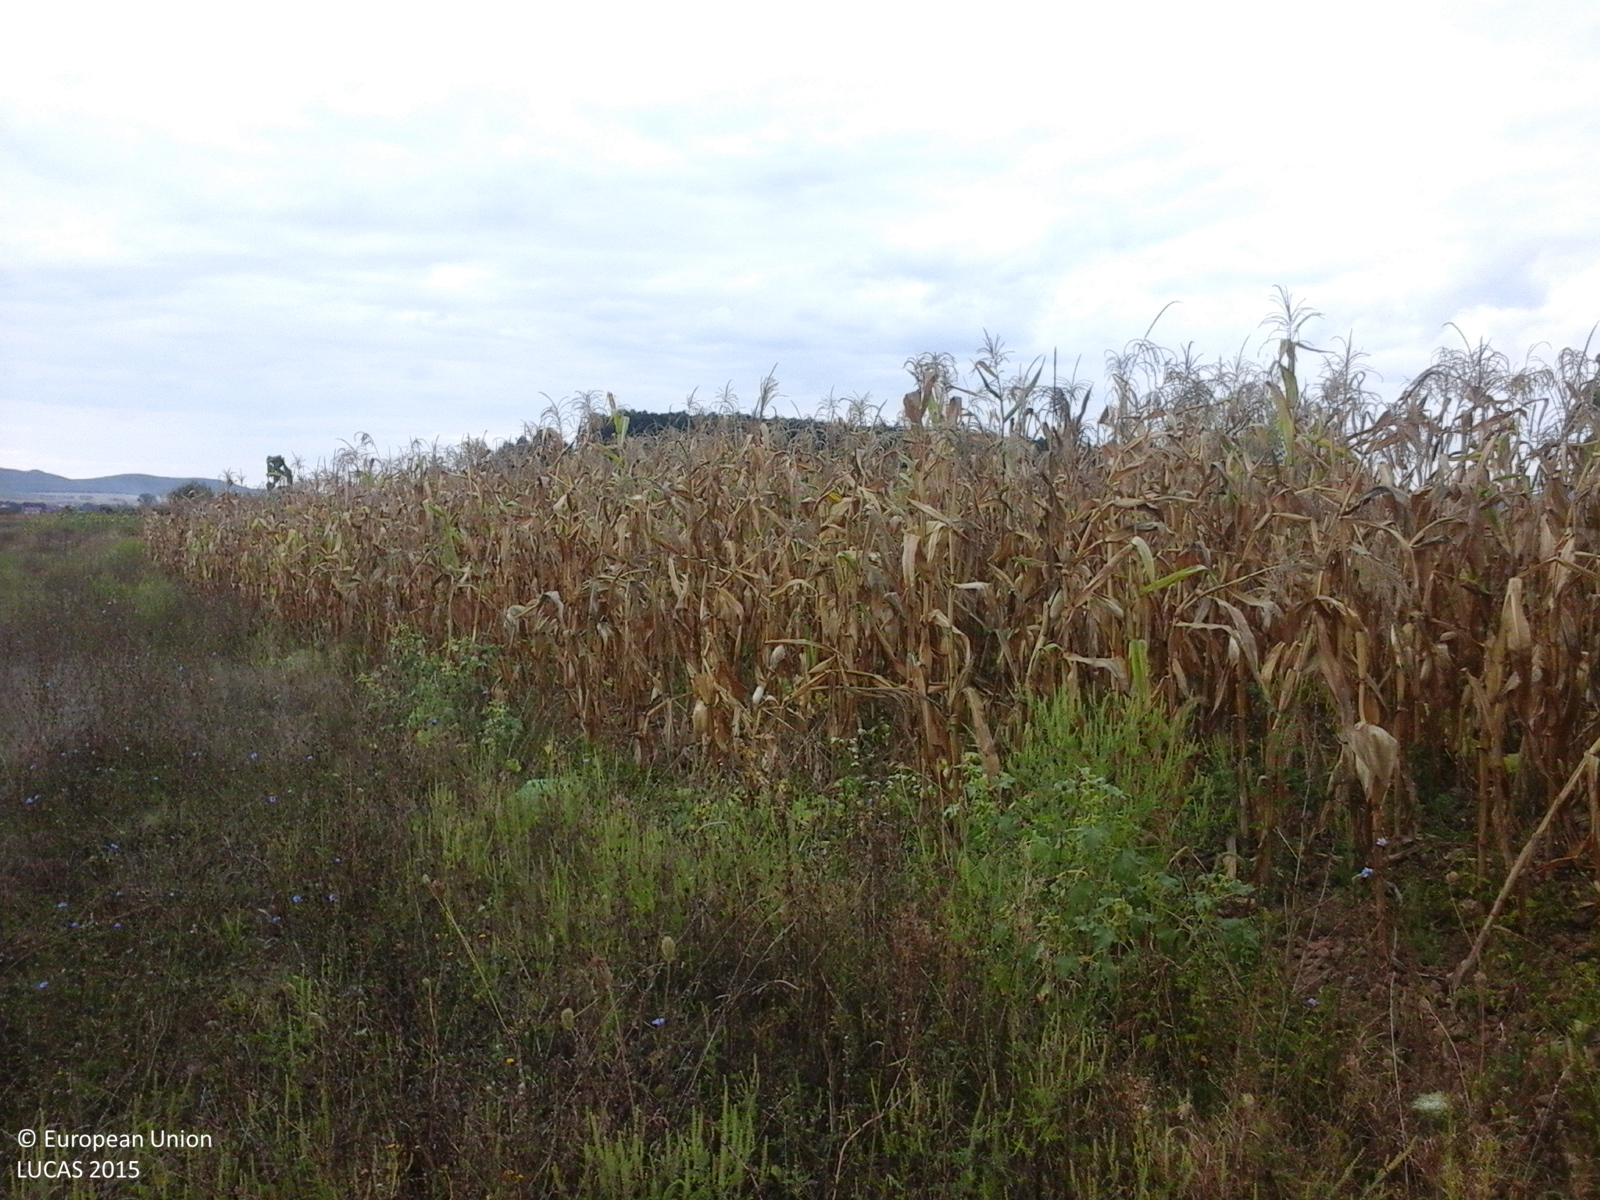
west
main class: Cropland
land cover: Maize
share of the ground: > 75 %
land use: Agriculture (excluding fallow land and kitchen gardens)
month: September
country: RO
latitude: 47.8425
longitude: 23.3686
